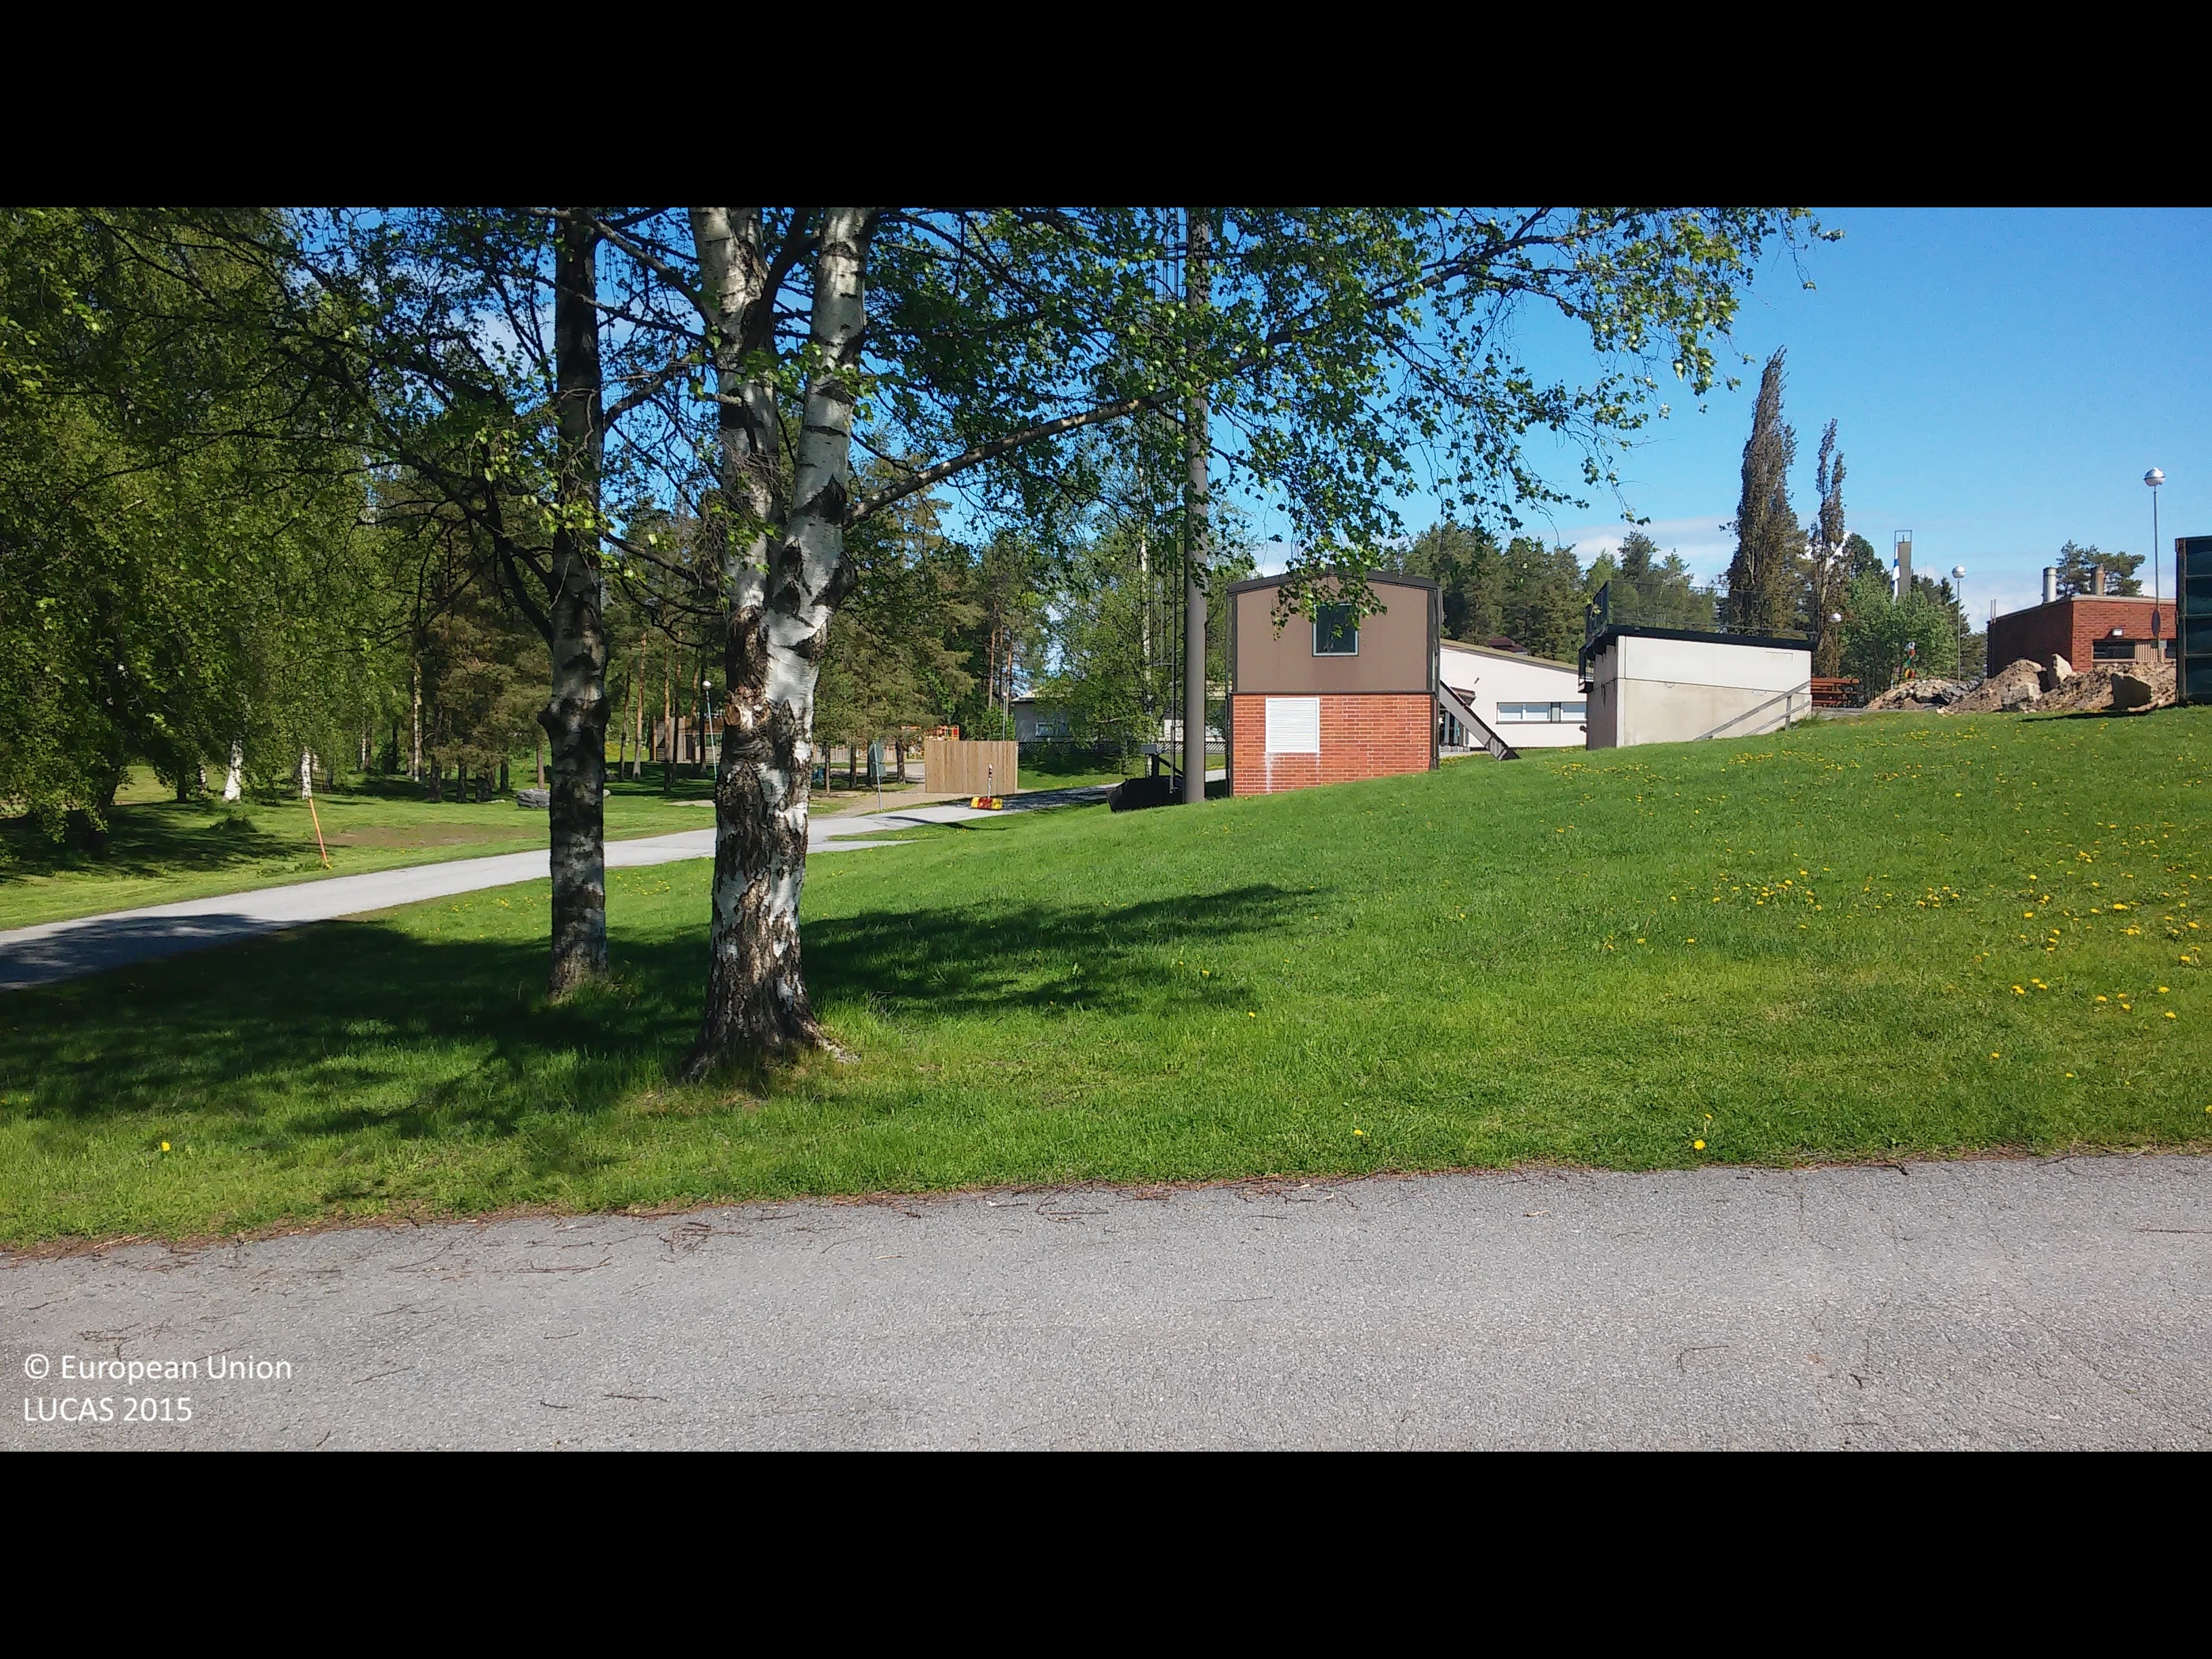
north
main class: Grassland
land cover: Grassland with sparse tree/shrub cover
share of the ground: > 75 %
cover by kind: herbaceous plants 95 %, broadleaved forest trees 5 %
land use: Community services
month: June
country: FI
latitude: 63.7296
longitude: 23.0330
